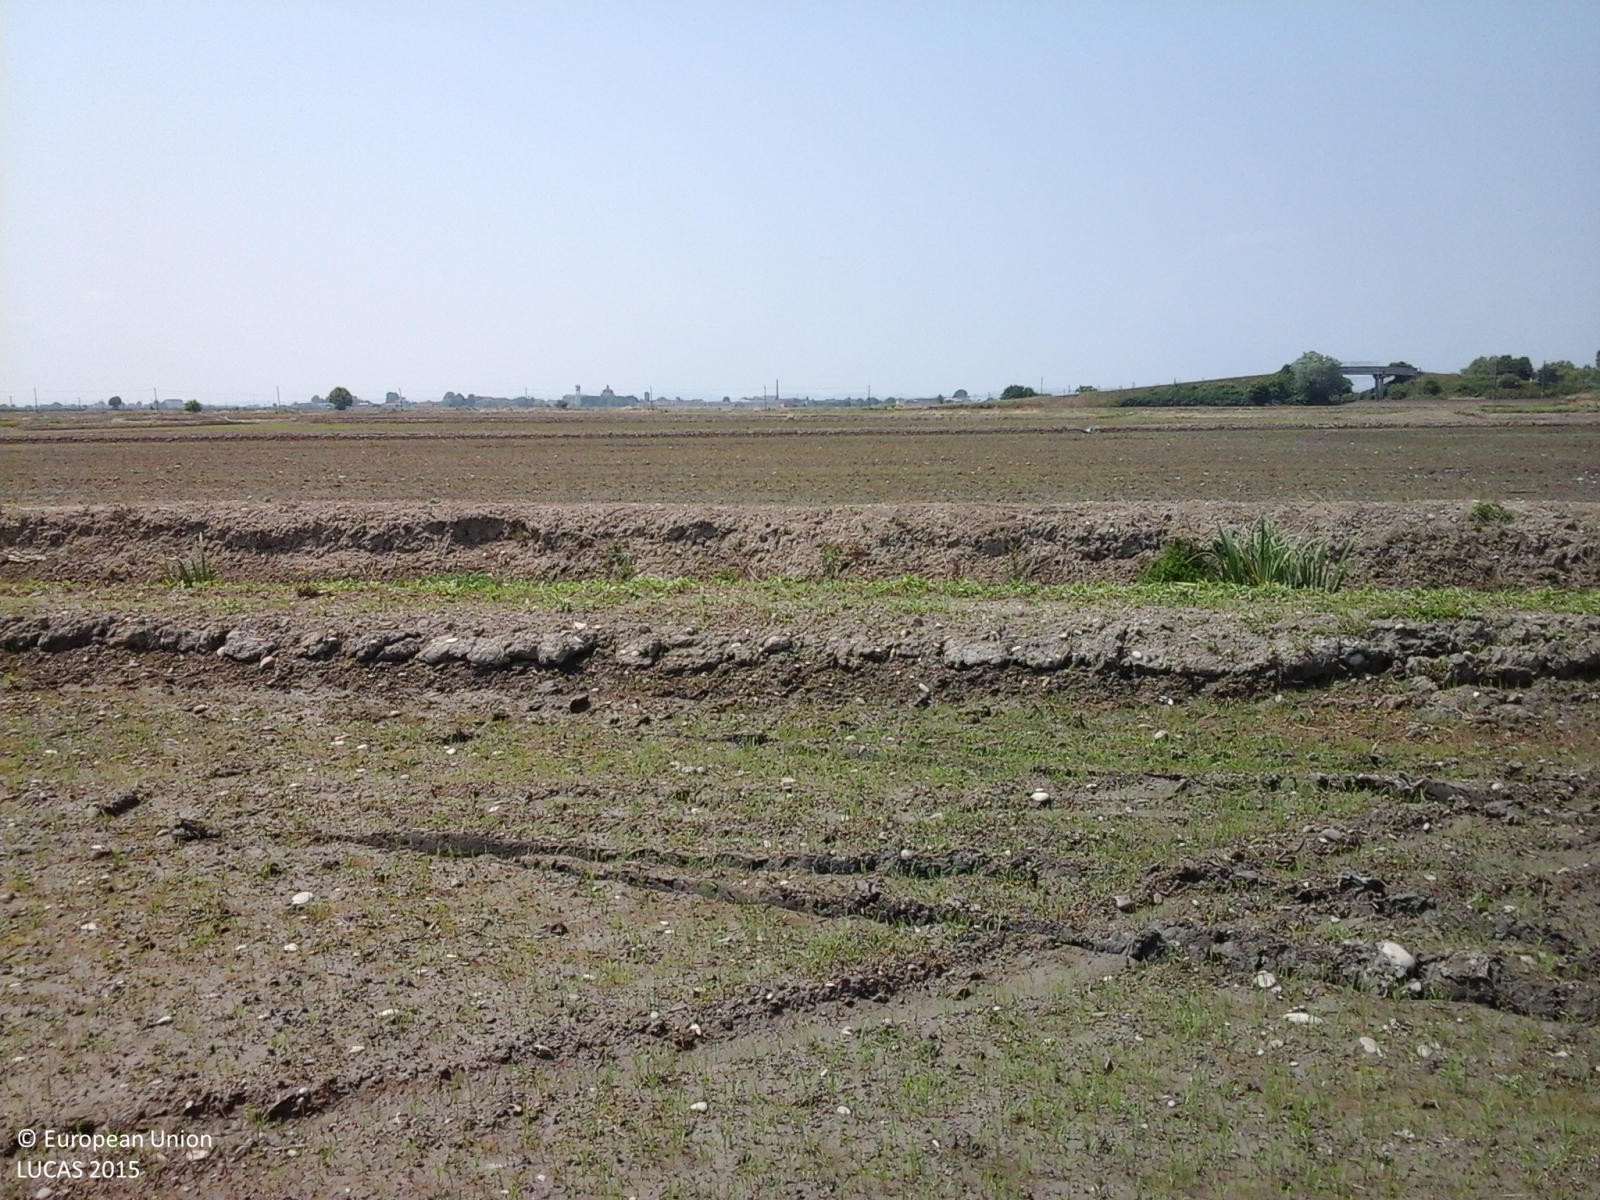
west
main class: Cropland
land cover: Rice
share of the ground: < 10 %
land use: Agriculture (excluding fallow land and kitchen gardens)
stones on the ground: < 10 %
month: May
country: IT
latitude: 45.3462
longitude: 8.2799
